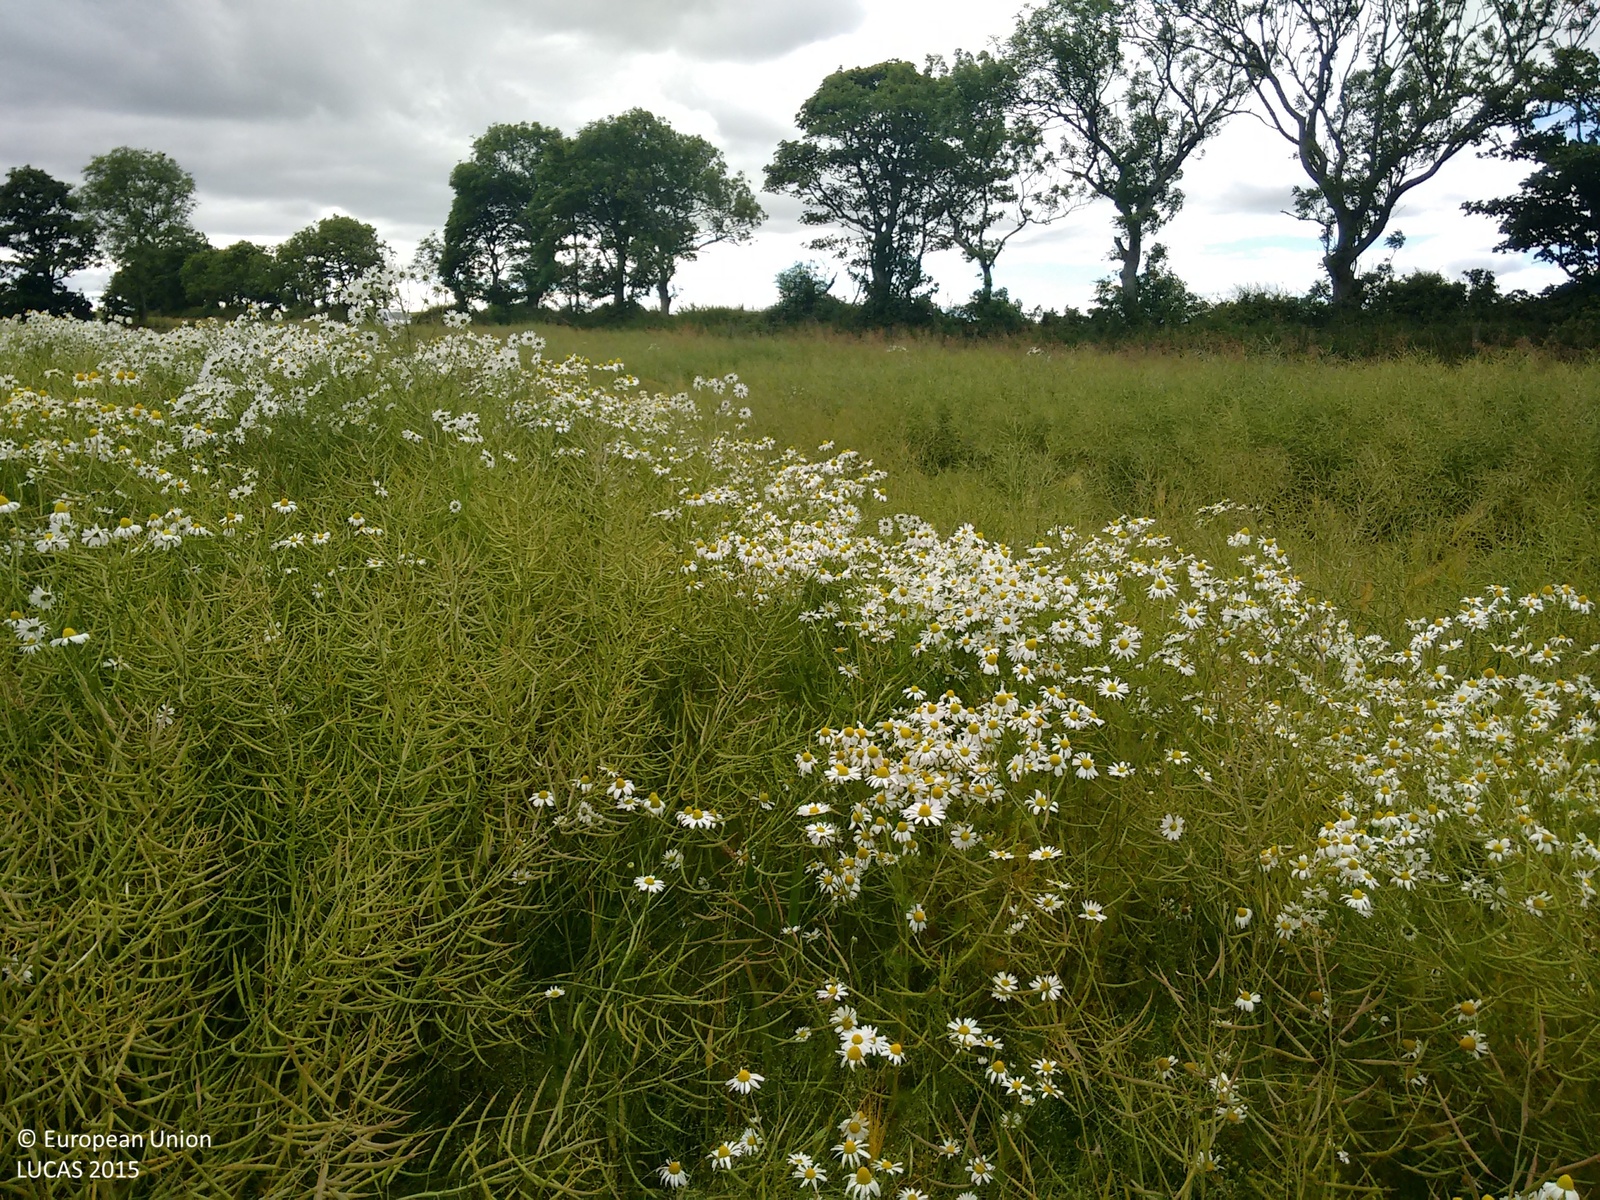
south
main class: Cropland
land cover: Rape and turnip rape
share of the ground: > 75 %
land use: Agriculture (excluding fallow land and kitchen gardens)
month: July
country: GB
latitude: 57.4996
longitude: -1.9759
